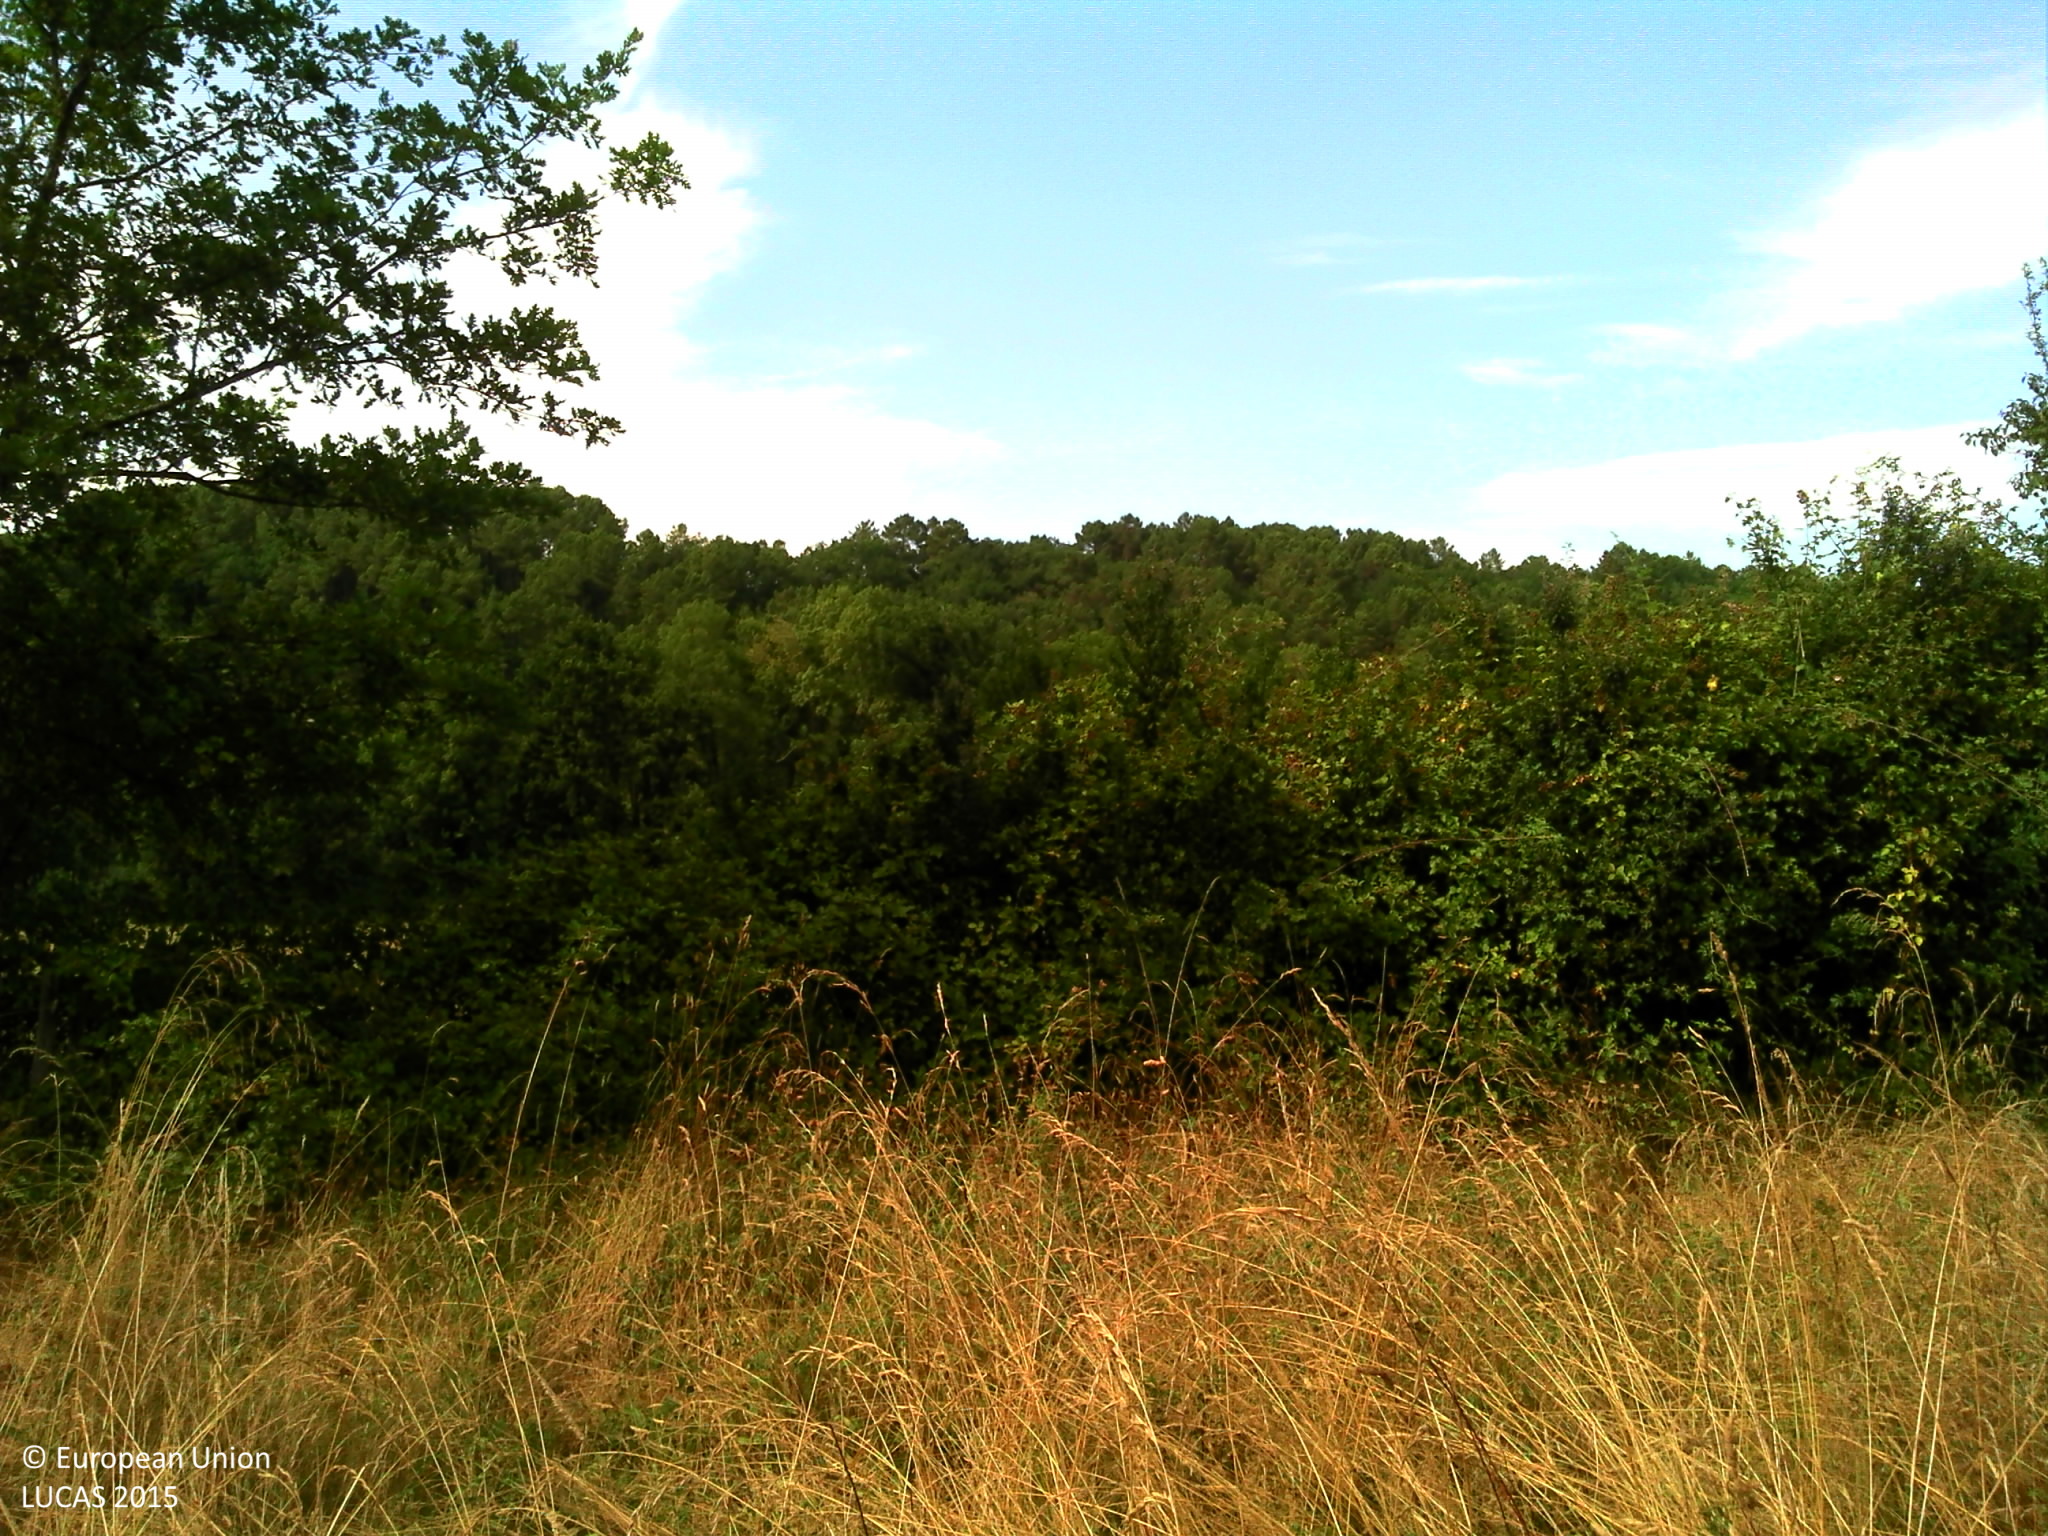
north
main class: Grassland
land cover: Grassland without tree/shrub cover
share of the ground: > 75 %
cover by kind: herbaceous plants 90 %, shrubs 5 %, unconsolidated bare surface 5 %
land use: Agriculture (excluding fallow land and kitchen gardens)
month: July
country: FR
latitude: 45.0619
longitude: 0.5538
